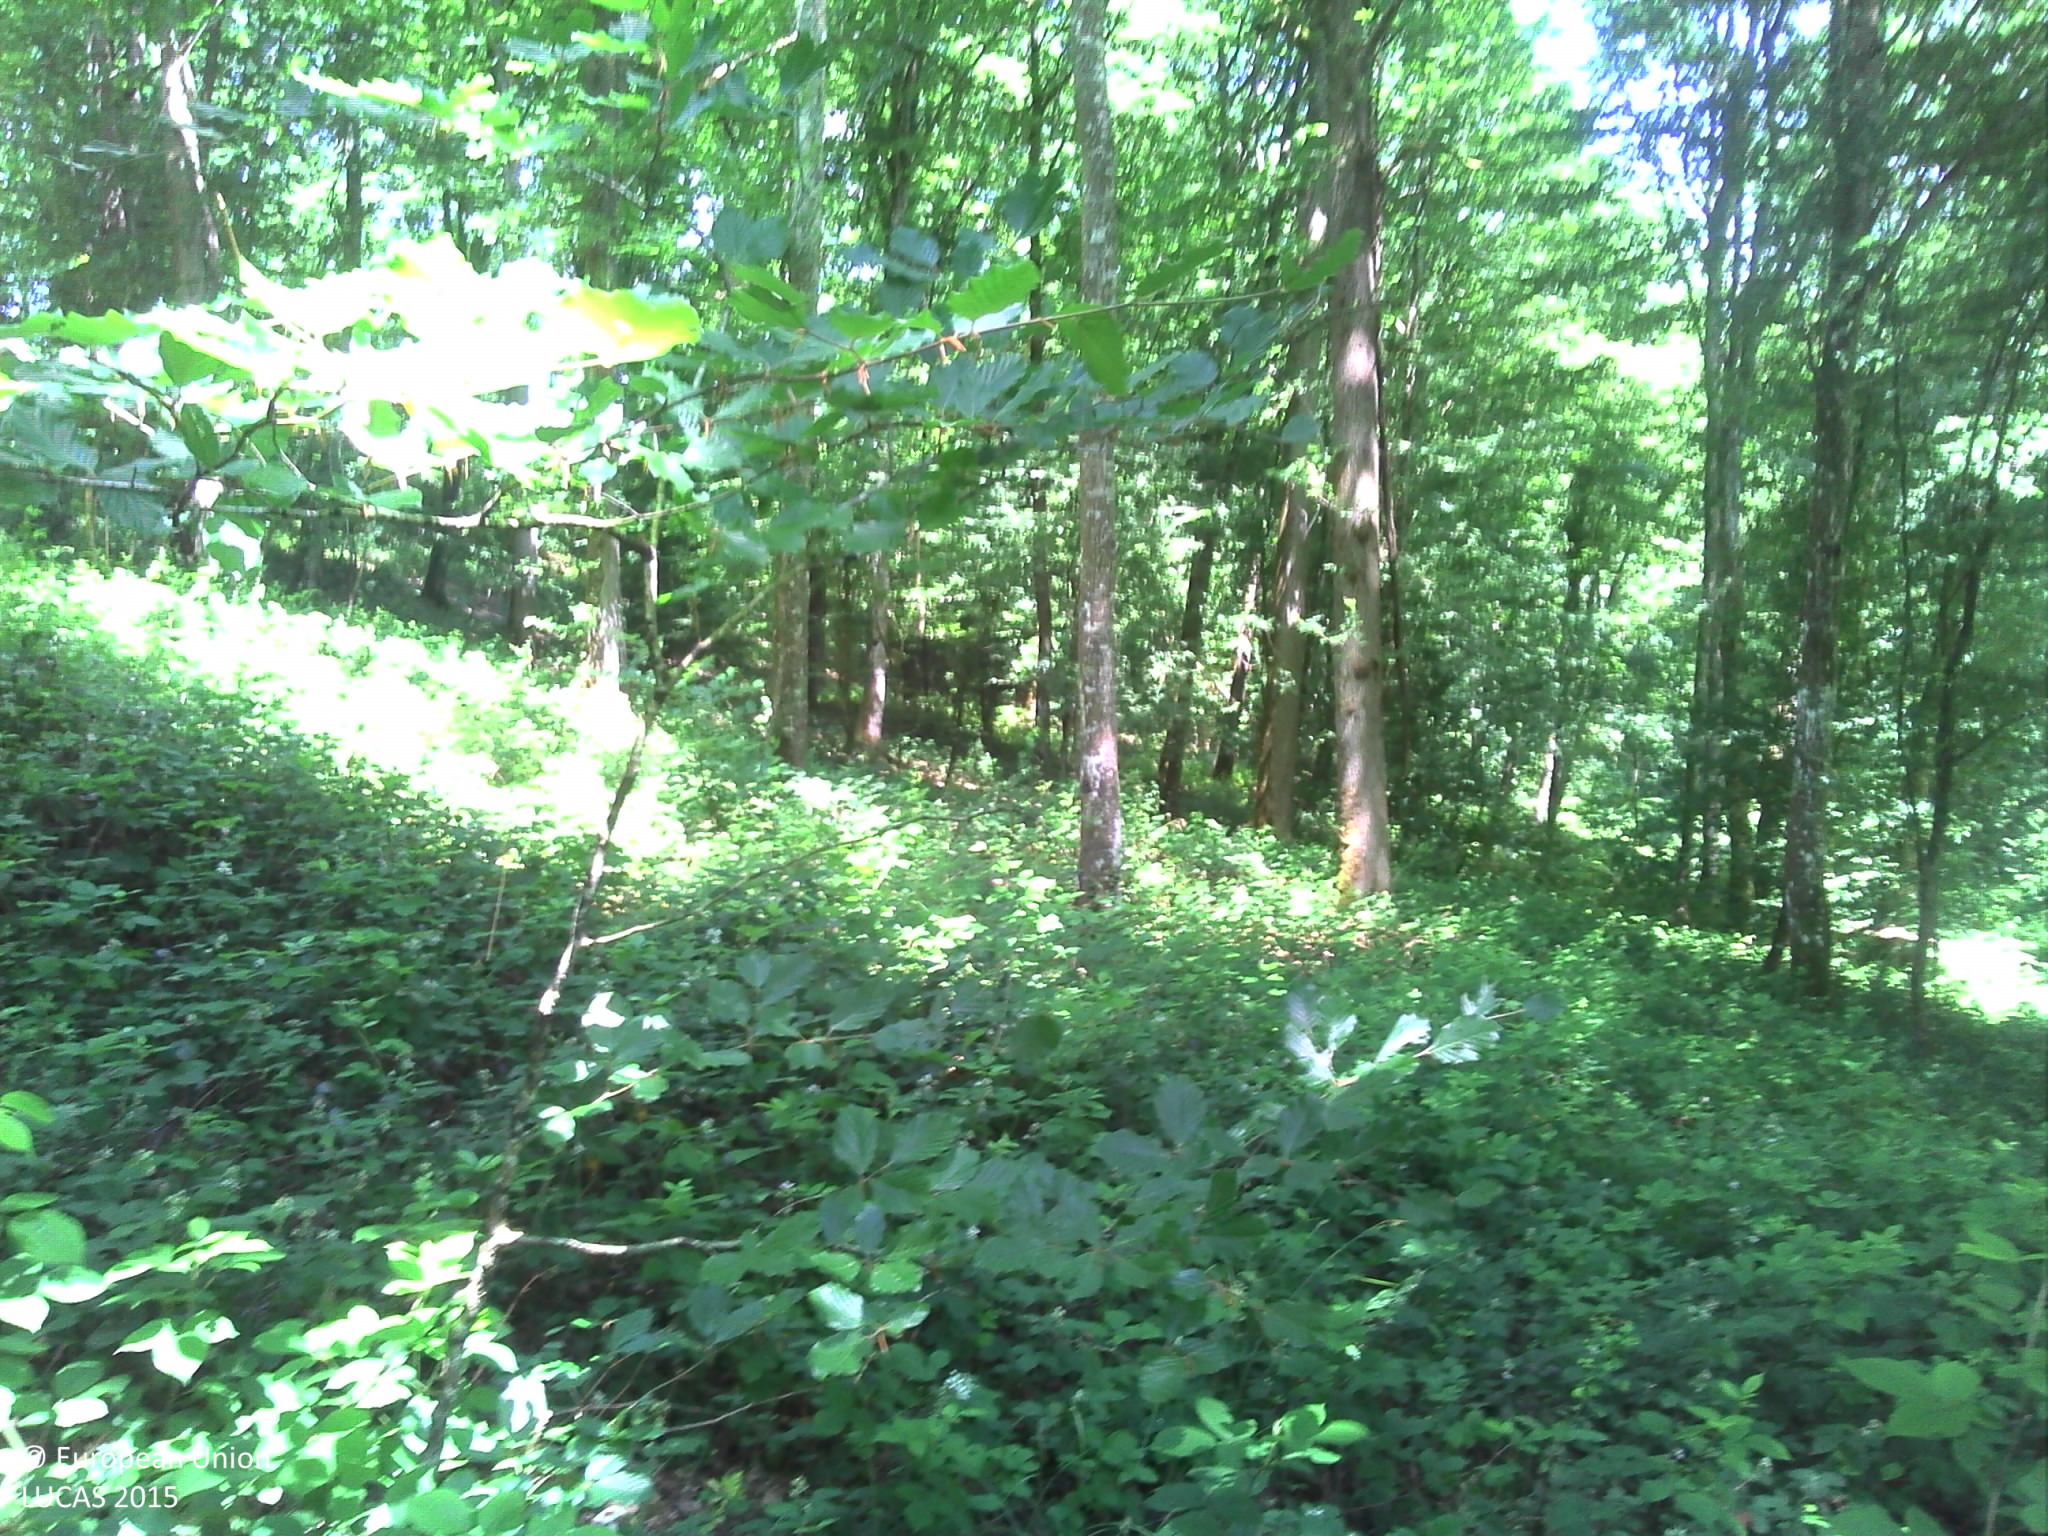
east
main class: Woodland
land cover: Broadleaved woodland
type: mesophytic deciduous forest
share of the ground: > 75 %
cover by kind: broadleaved forest trees 80 %, herbaceous plants 10 %, consolidated bare surface 10 %
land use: Forestry
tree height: > 5 m
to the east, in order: Broadleaved woodland; Spruce dominated coniferous woodland
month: June
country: FR
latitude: 49.1287
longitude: 1.0848
